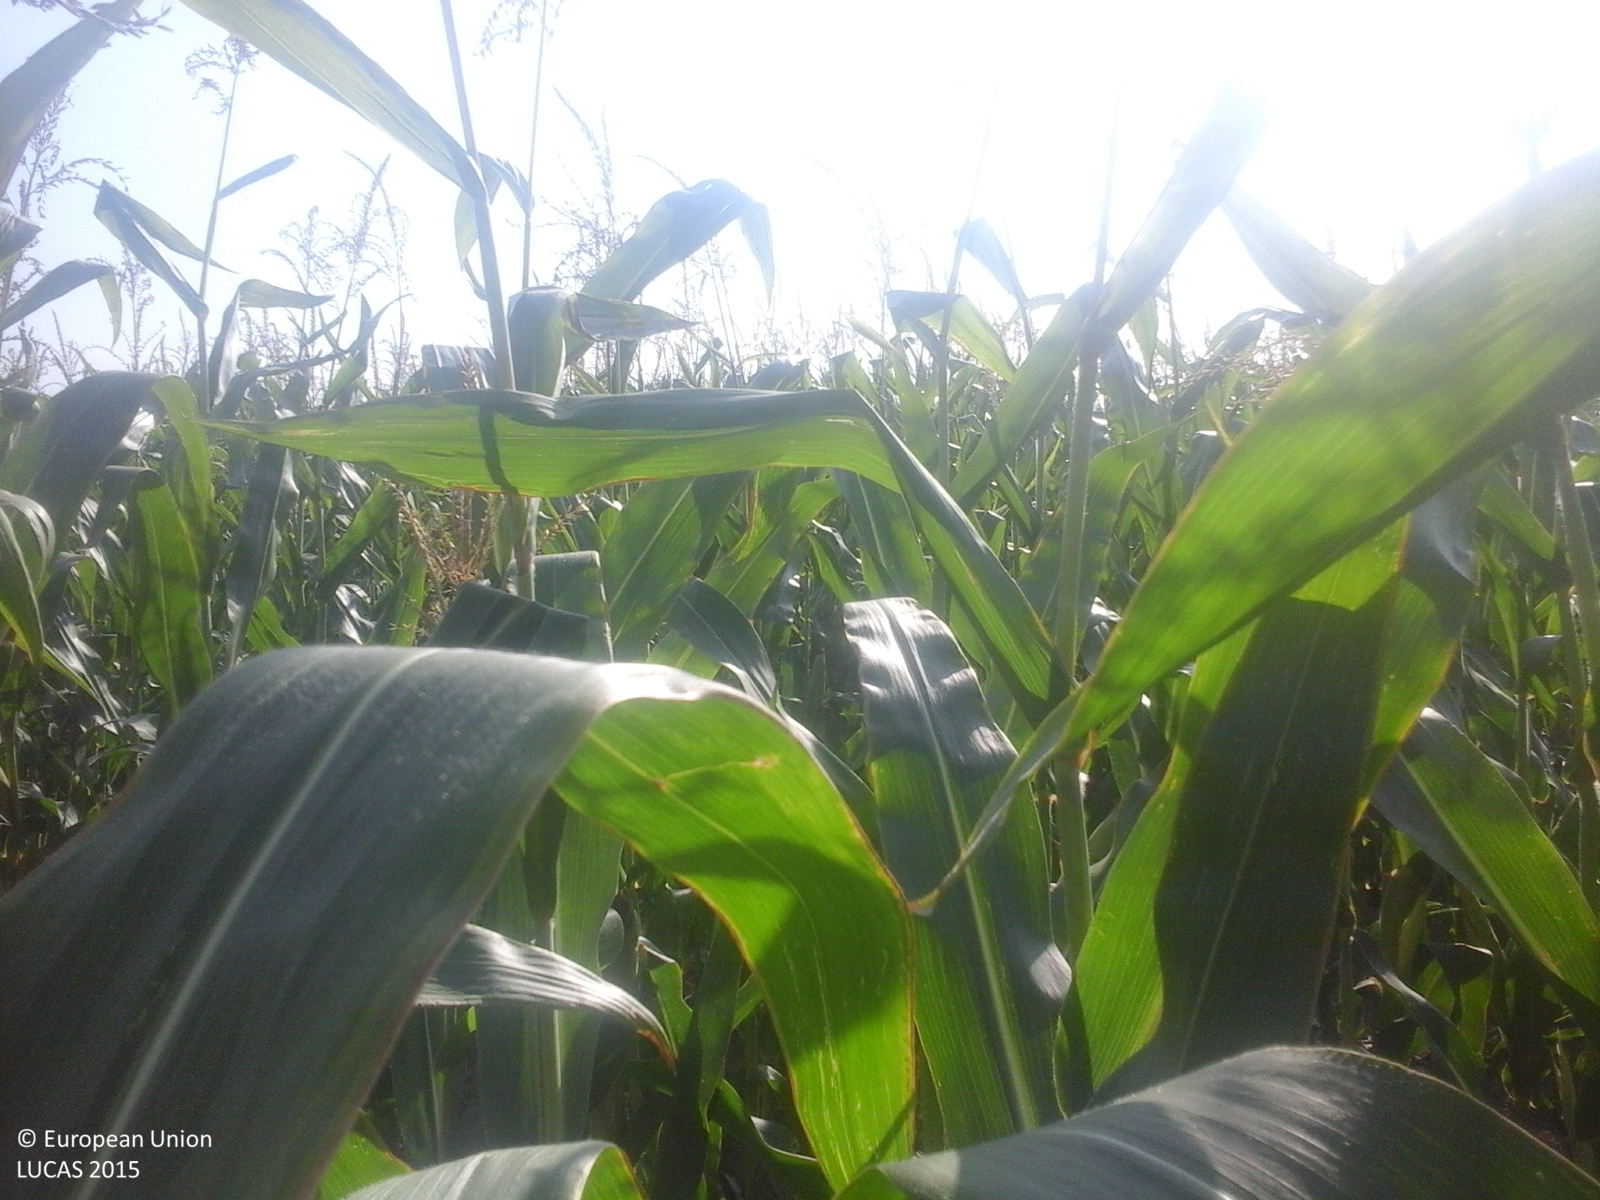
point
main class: Cropland
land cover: Maize
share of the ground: > 75 %
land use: Agriculture (excluding fallow land and kitchen gardens)
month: August
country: RO
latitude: 44.0233
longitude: 28.2626
